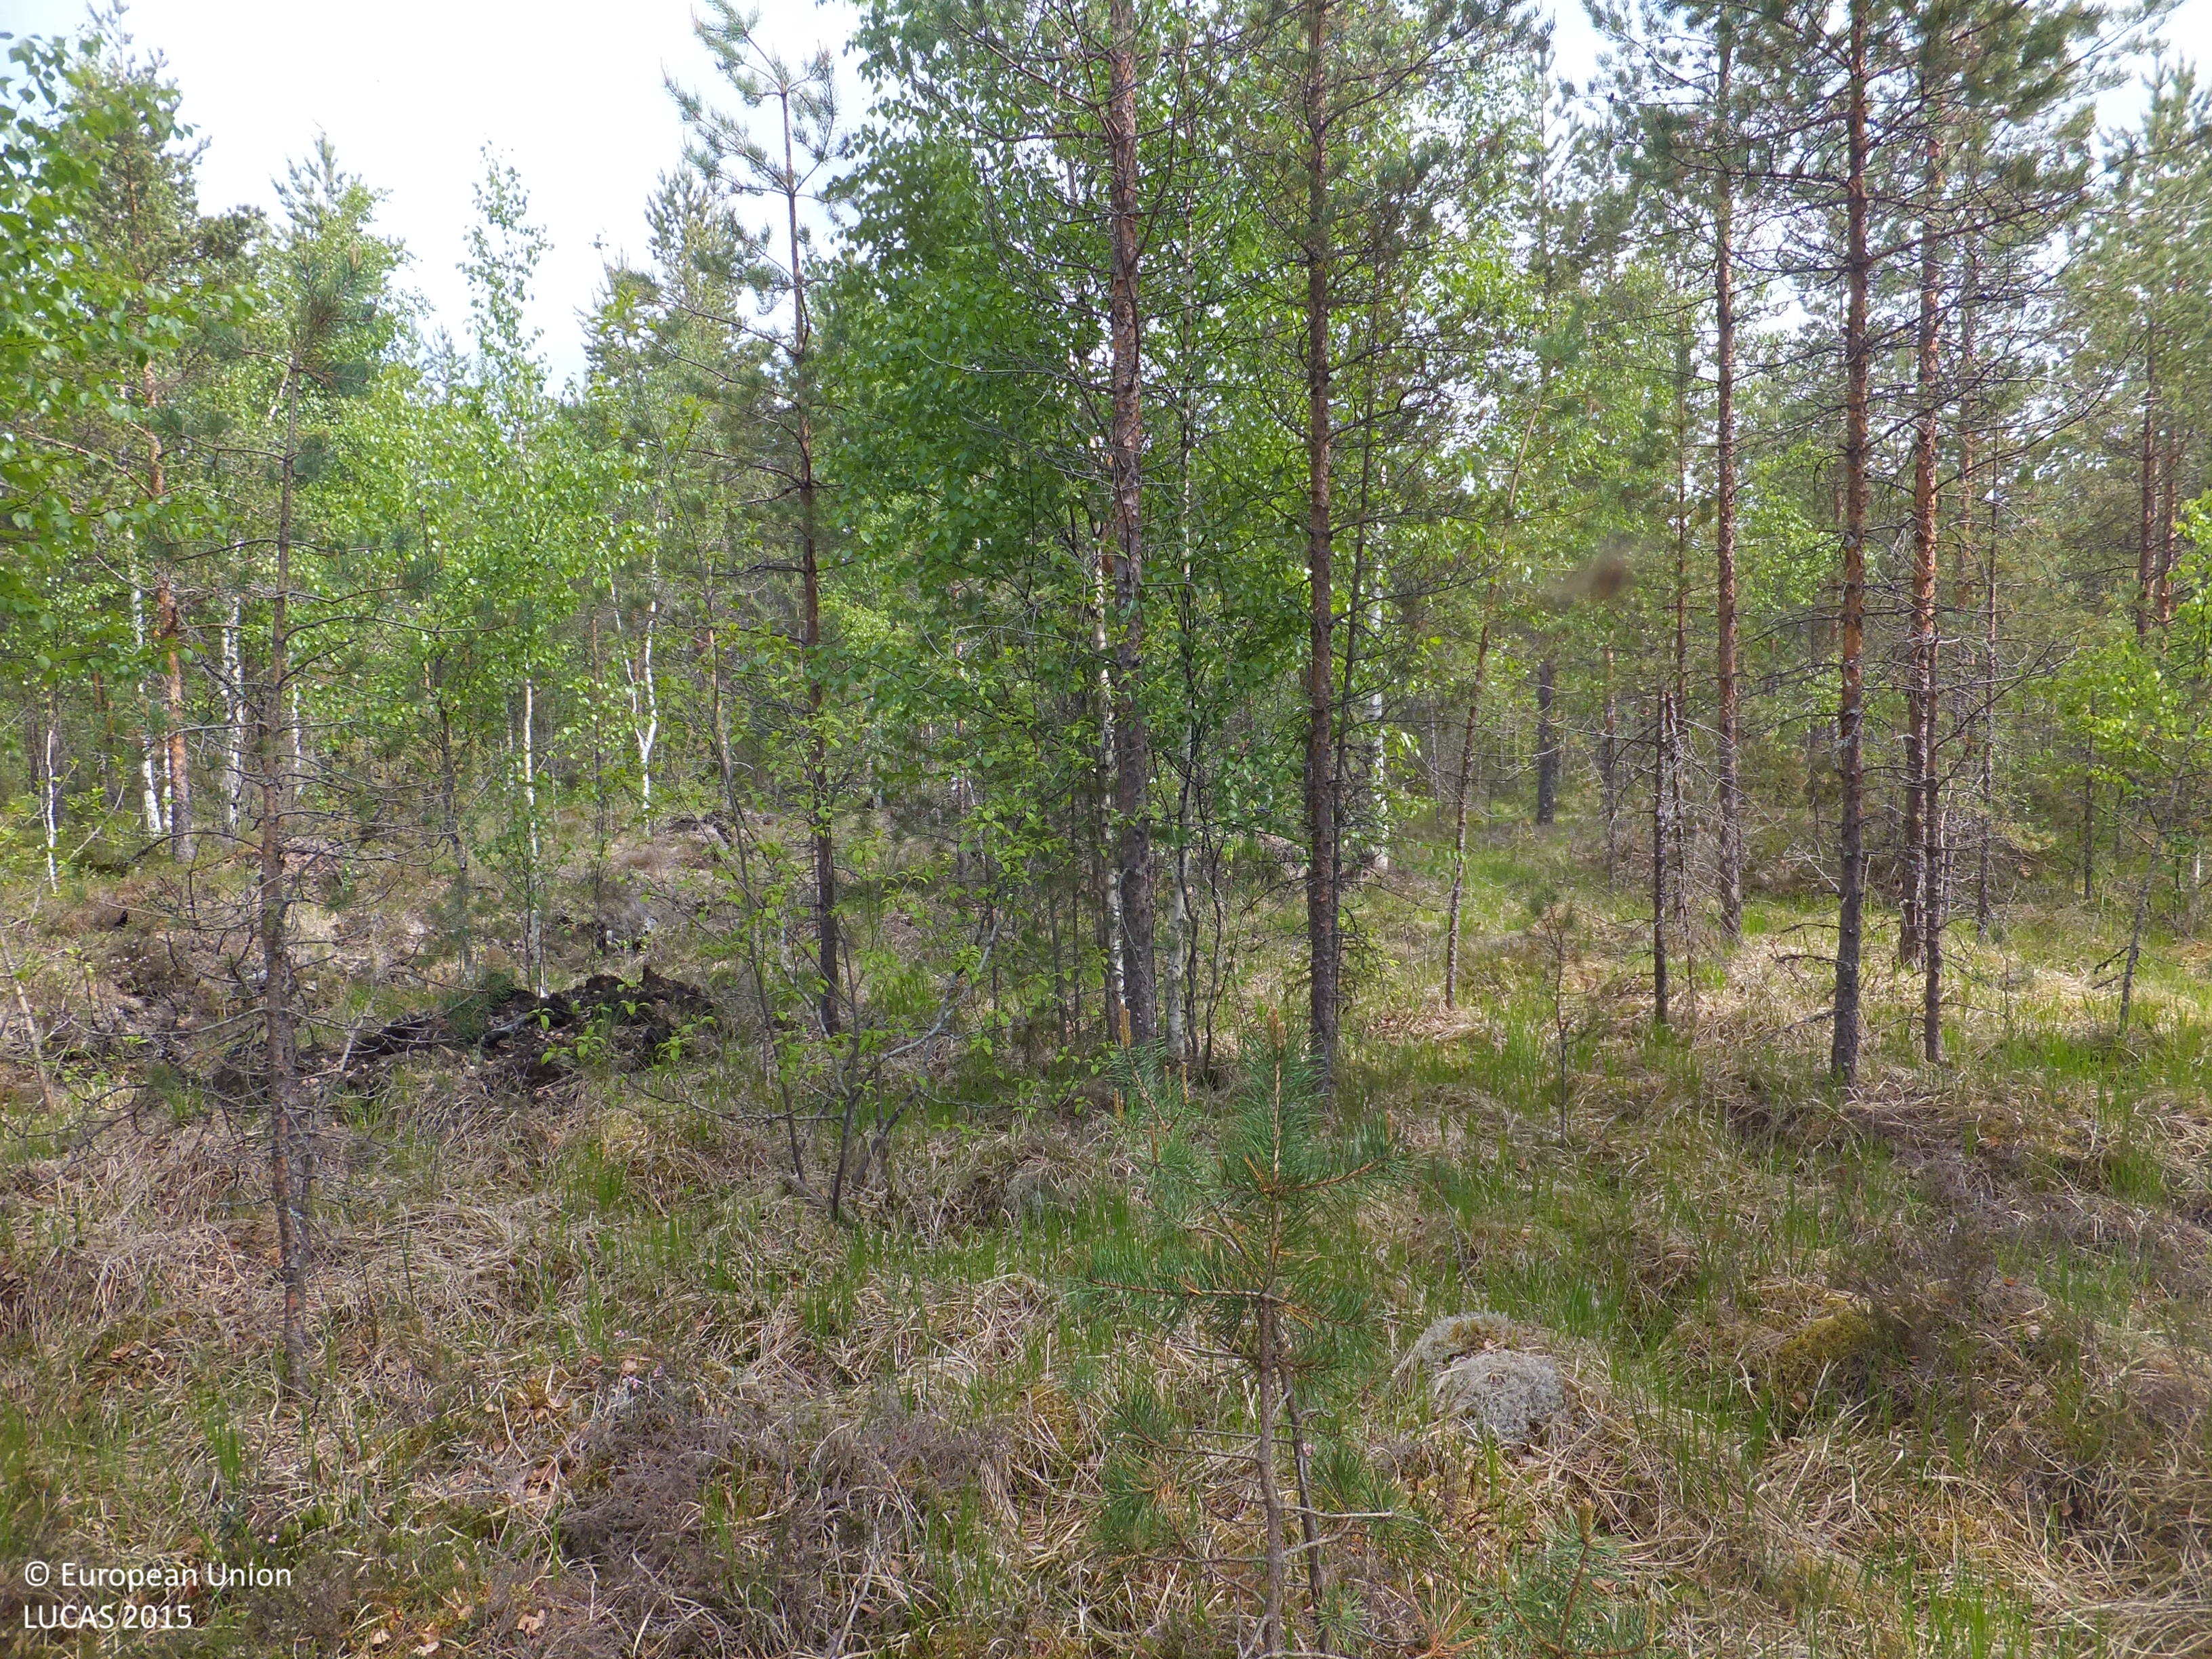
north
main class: Woodland
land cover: Pine dominated mixed woodland
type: boreal forest
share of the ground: 50 - 75 %
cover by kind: coniferous forest trees 30 %, broadleaved forest trees 30 %, herbaceous plants 15 %, lichens and mosses 15 %, shrubs 10 %
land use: Forestry
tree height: > 5 m
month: June
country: FI
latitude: 63.5906
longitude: 24.7751
